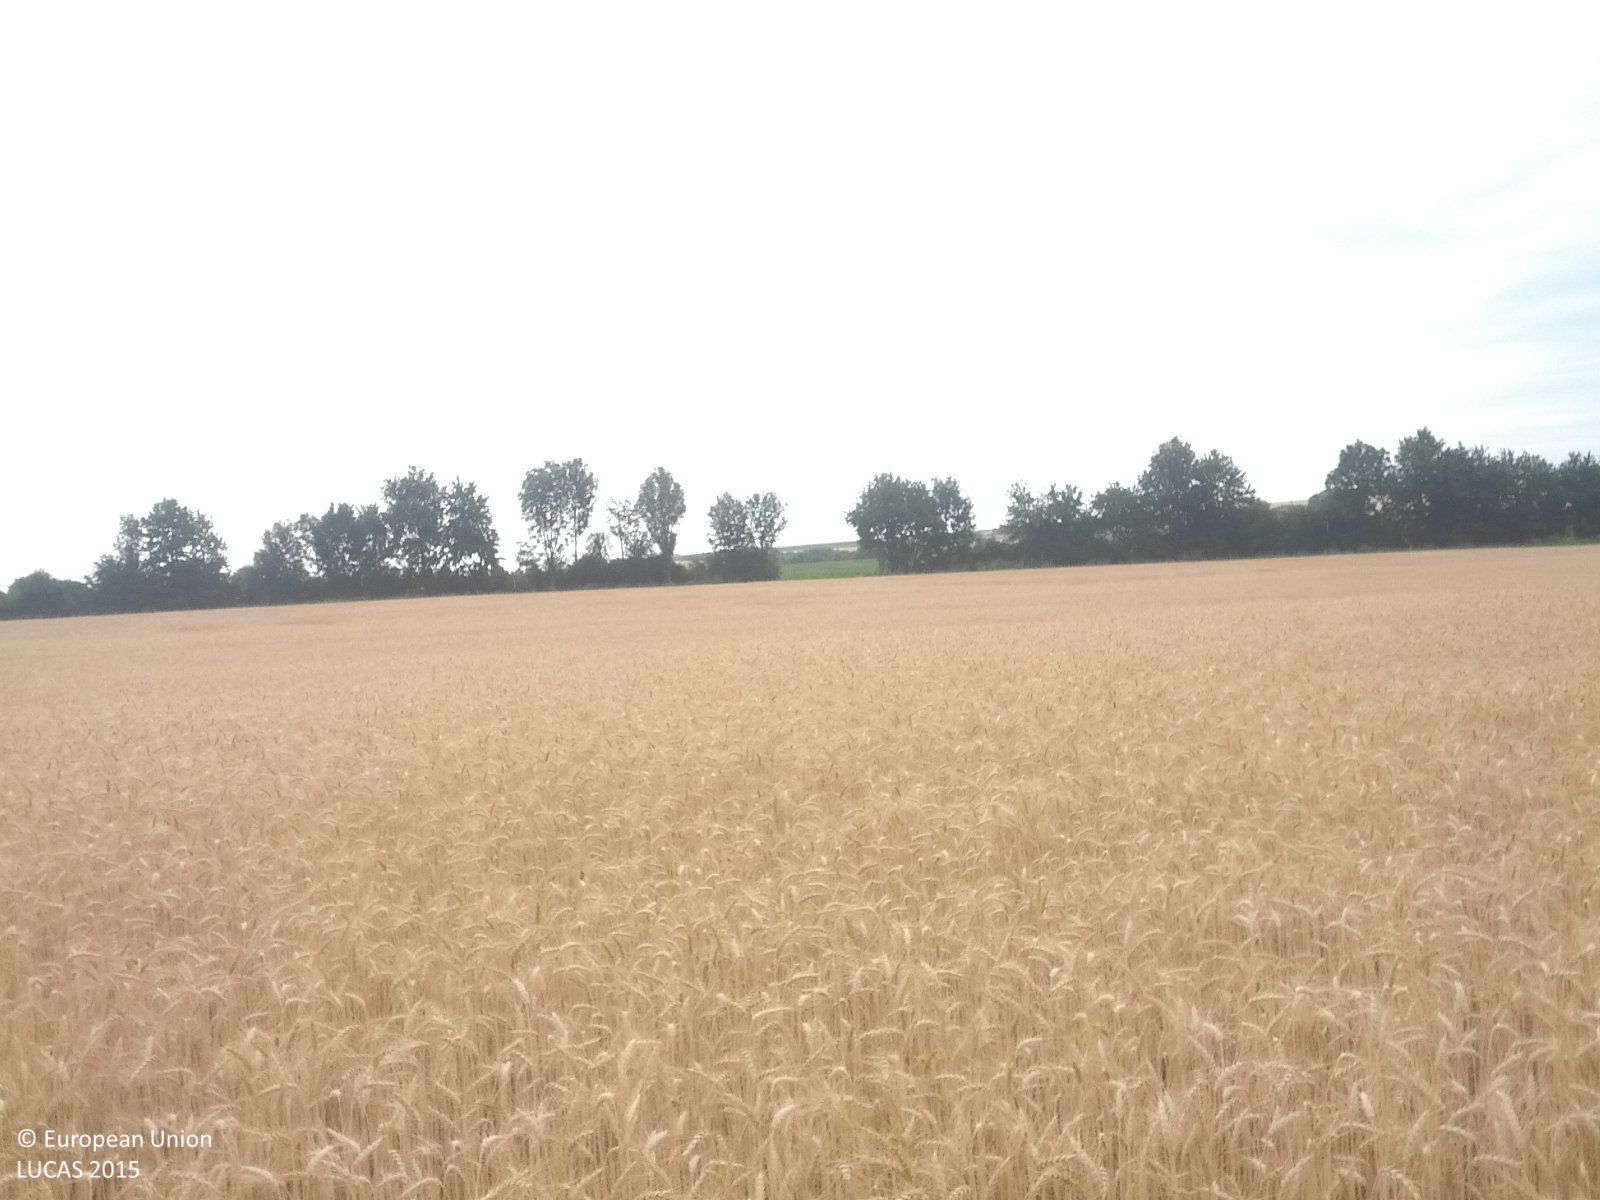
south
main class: Cropland
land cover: Common wheat
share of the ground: > 75 %
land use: Agriculture (excluding fallow land and kitchen gardens)
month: July
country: AT
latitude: 48.7818
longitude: 16.6348
